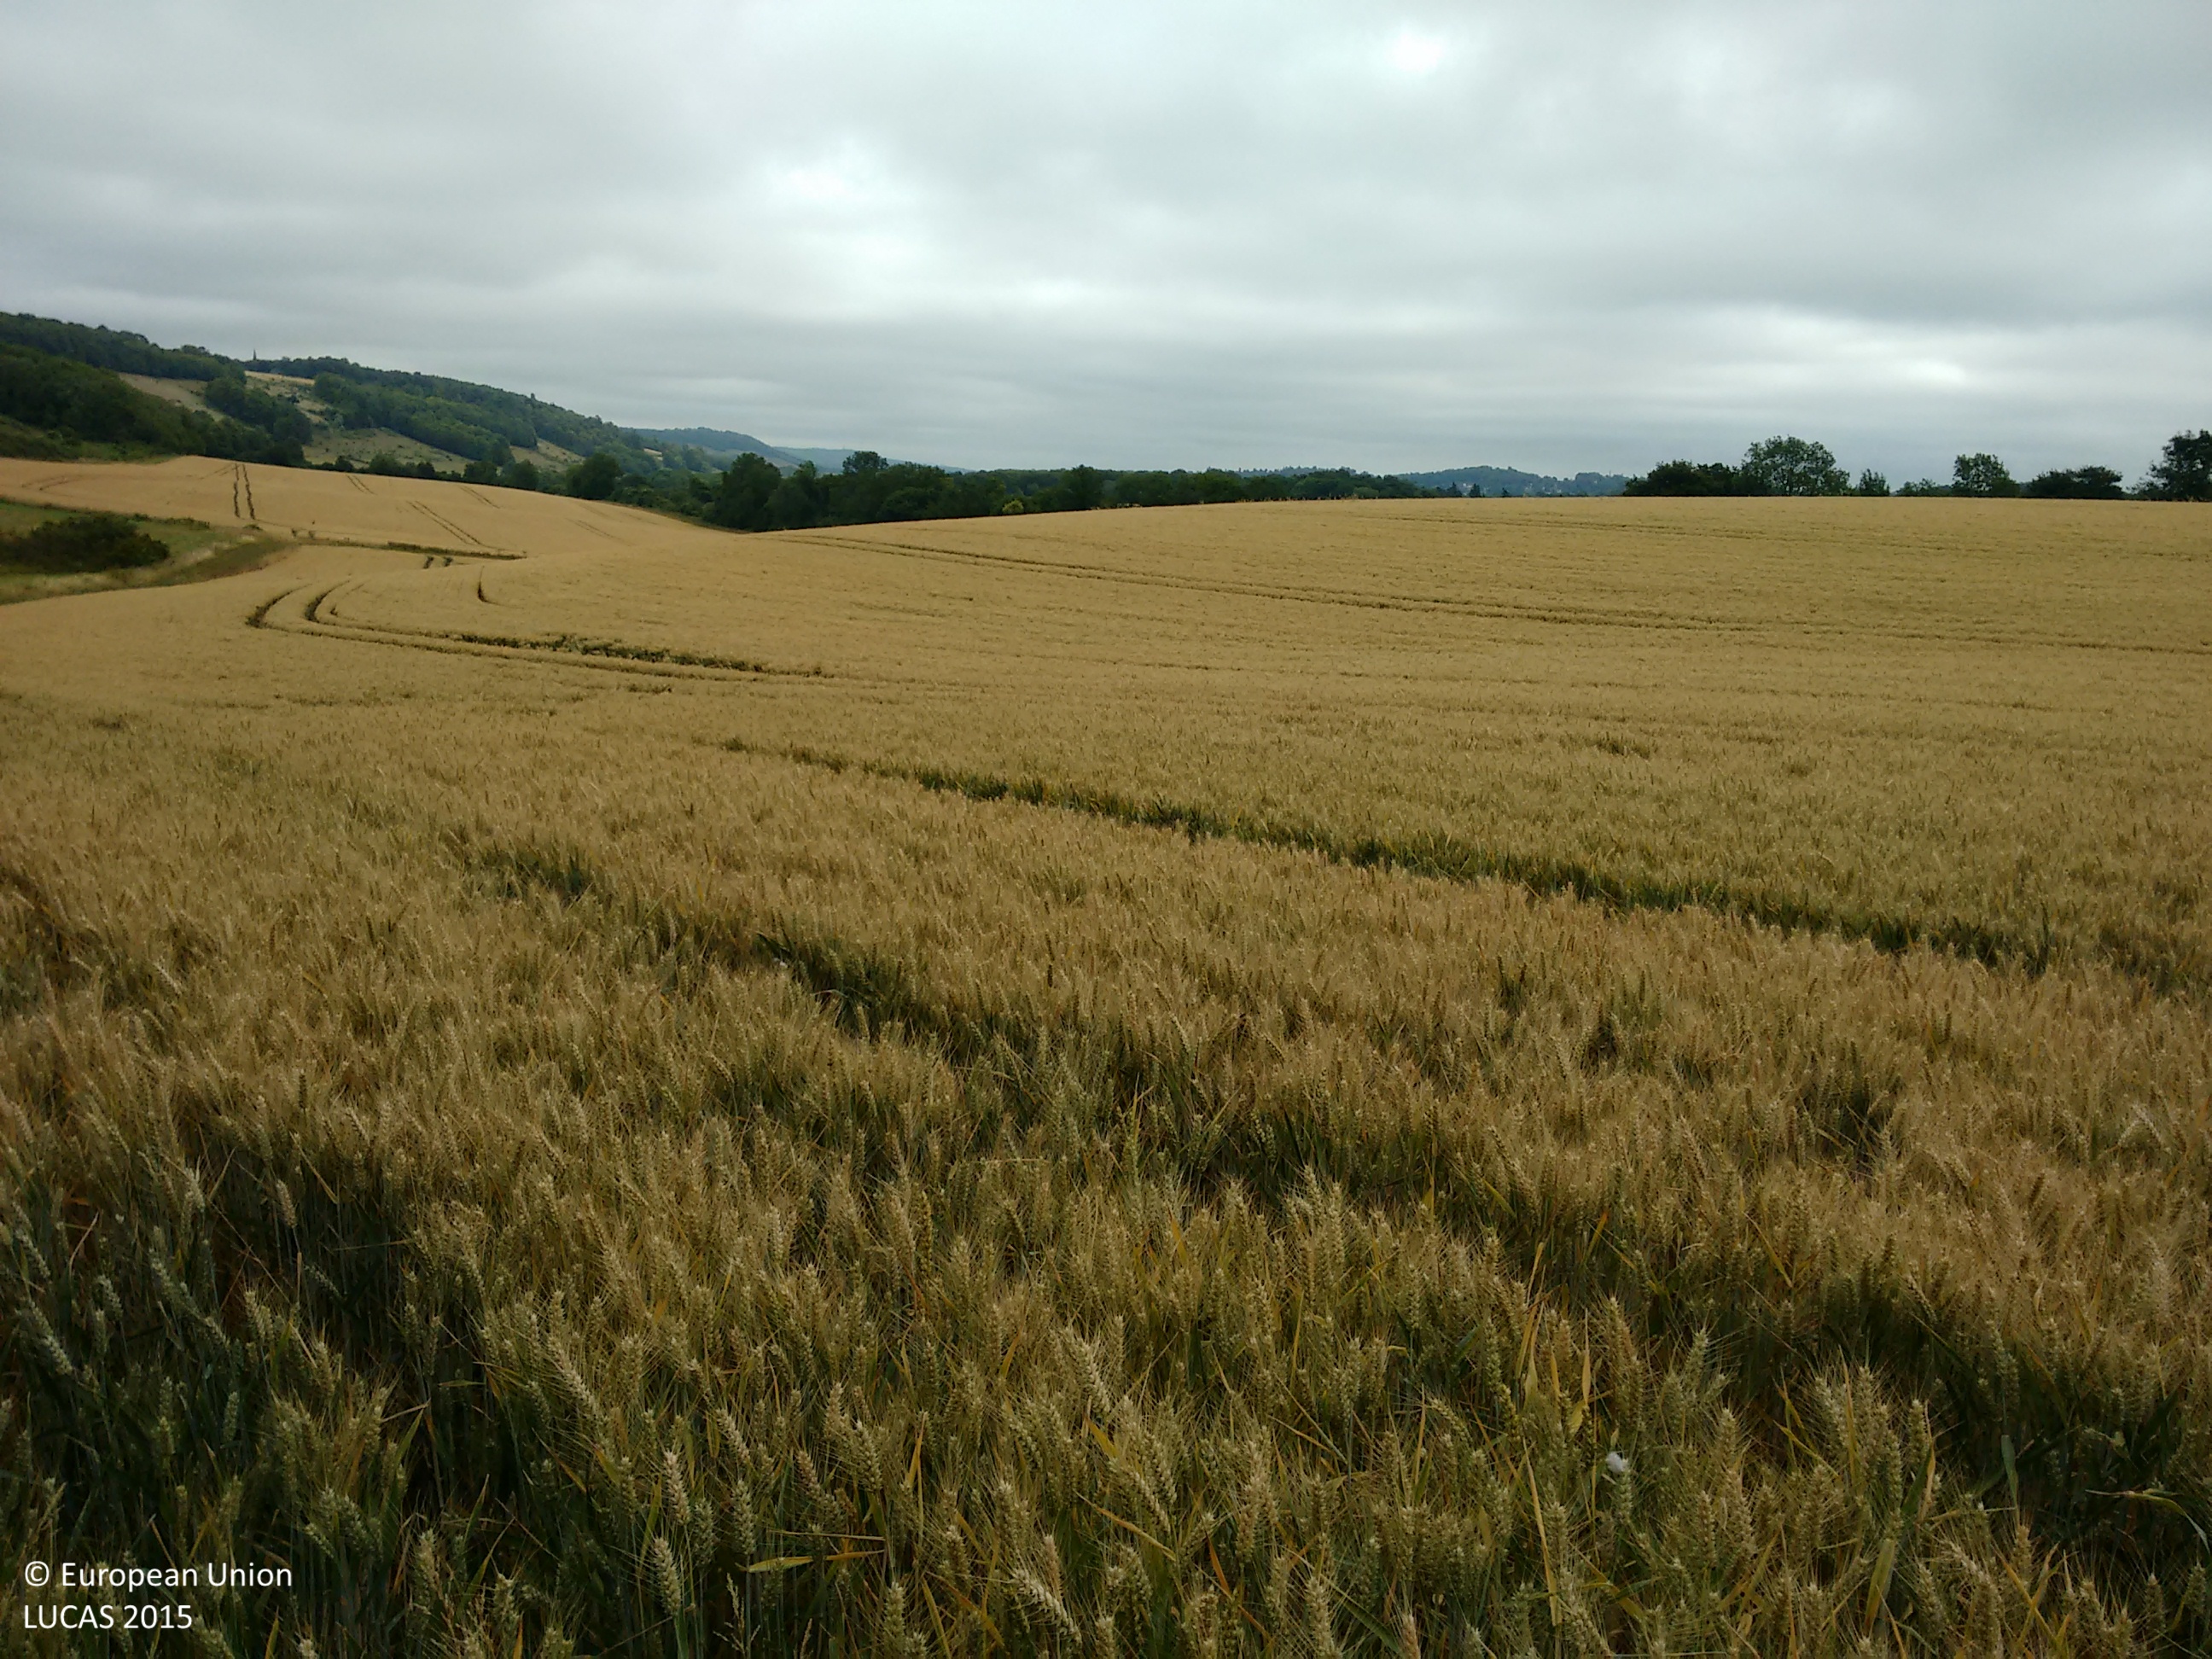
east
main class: Cropland
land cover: Common wheat
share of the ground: > 75 %
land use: Agriculture (excluding fallow land and kitchen gardens)
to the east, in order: Common wheat
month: July
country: GB
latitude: 51.2312
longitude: -0.3913
